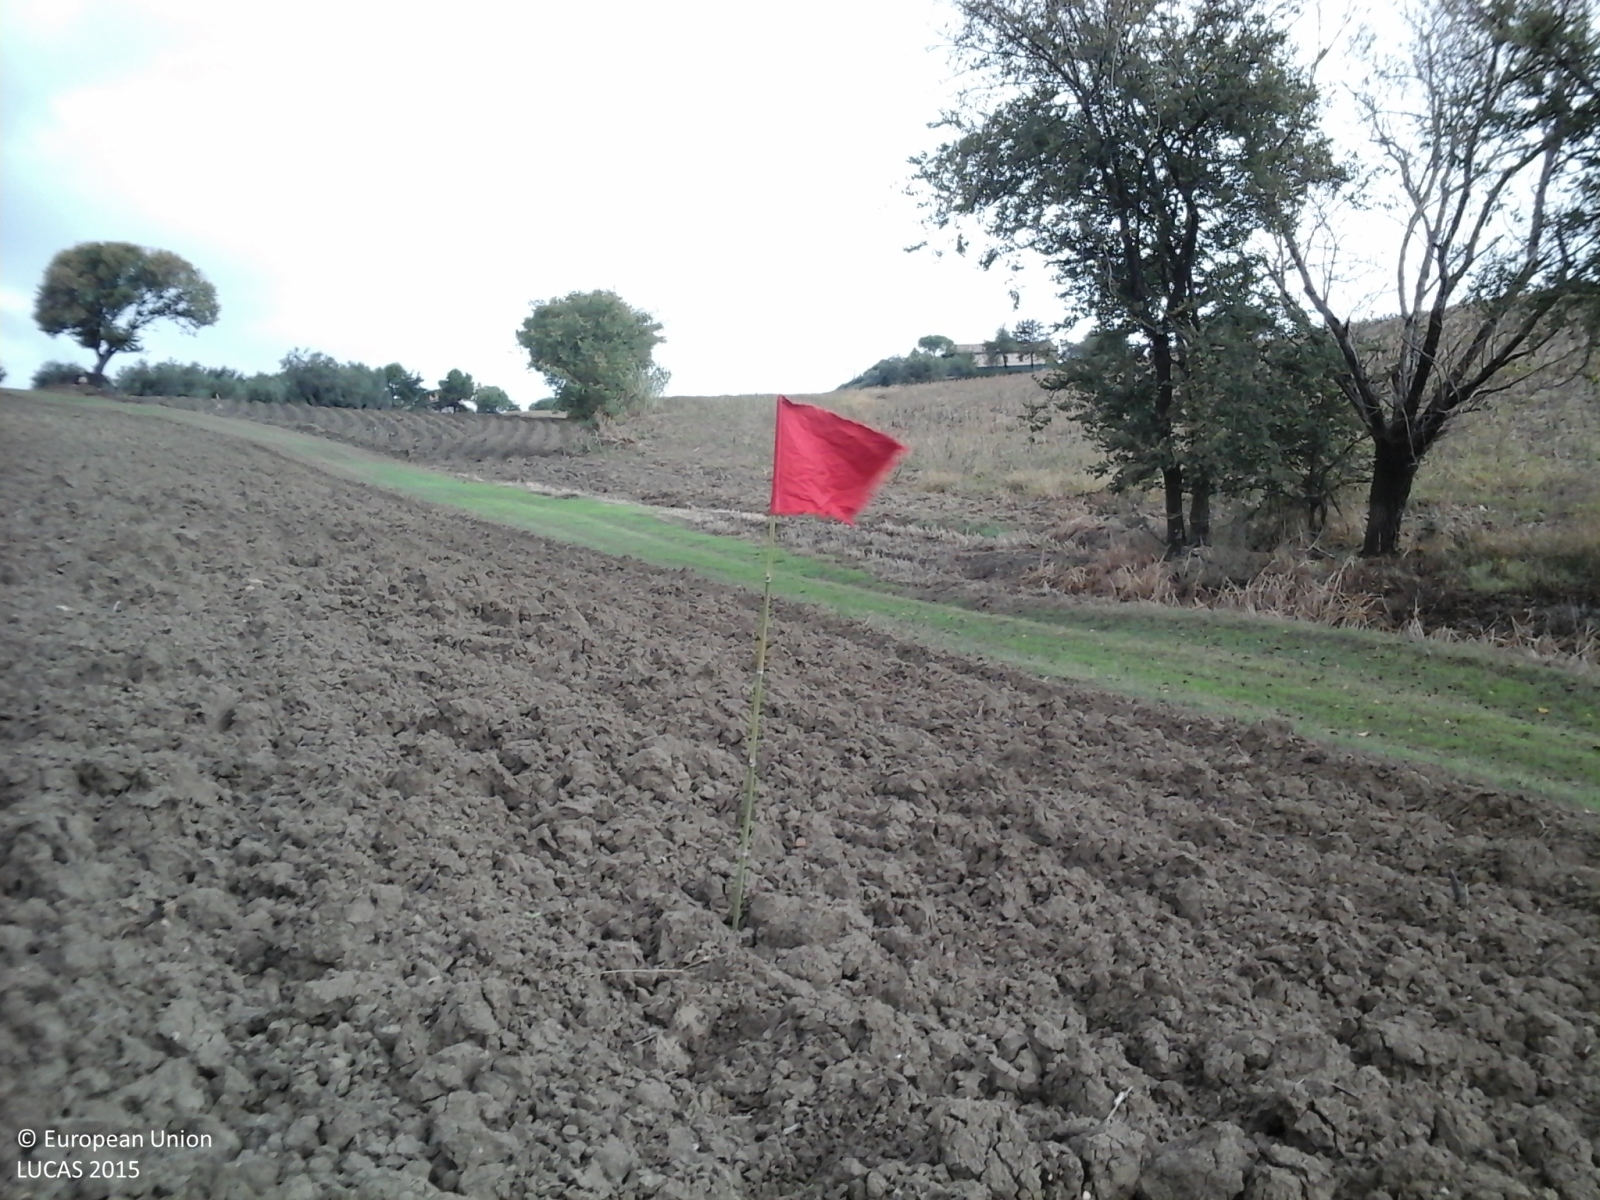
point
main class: Cropland
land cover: Sunflower
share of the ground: < 10 %
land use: Agriculture (excluding fallow land and kitchen gardens)
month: October
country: IT
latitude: 43.6865
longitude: 13.2302
